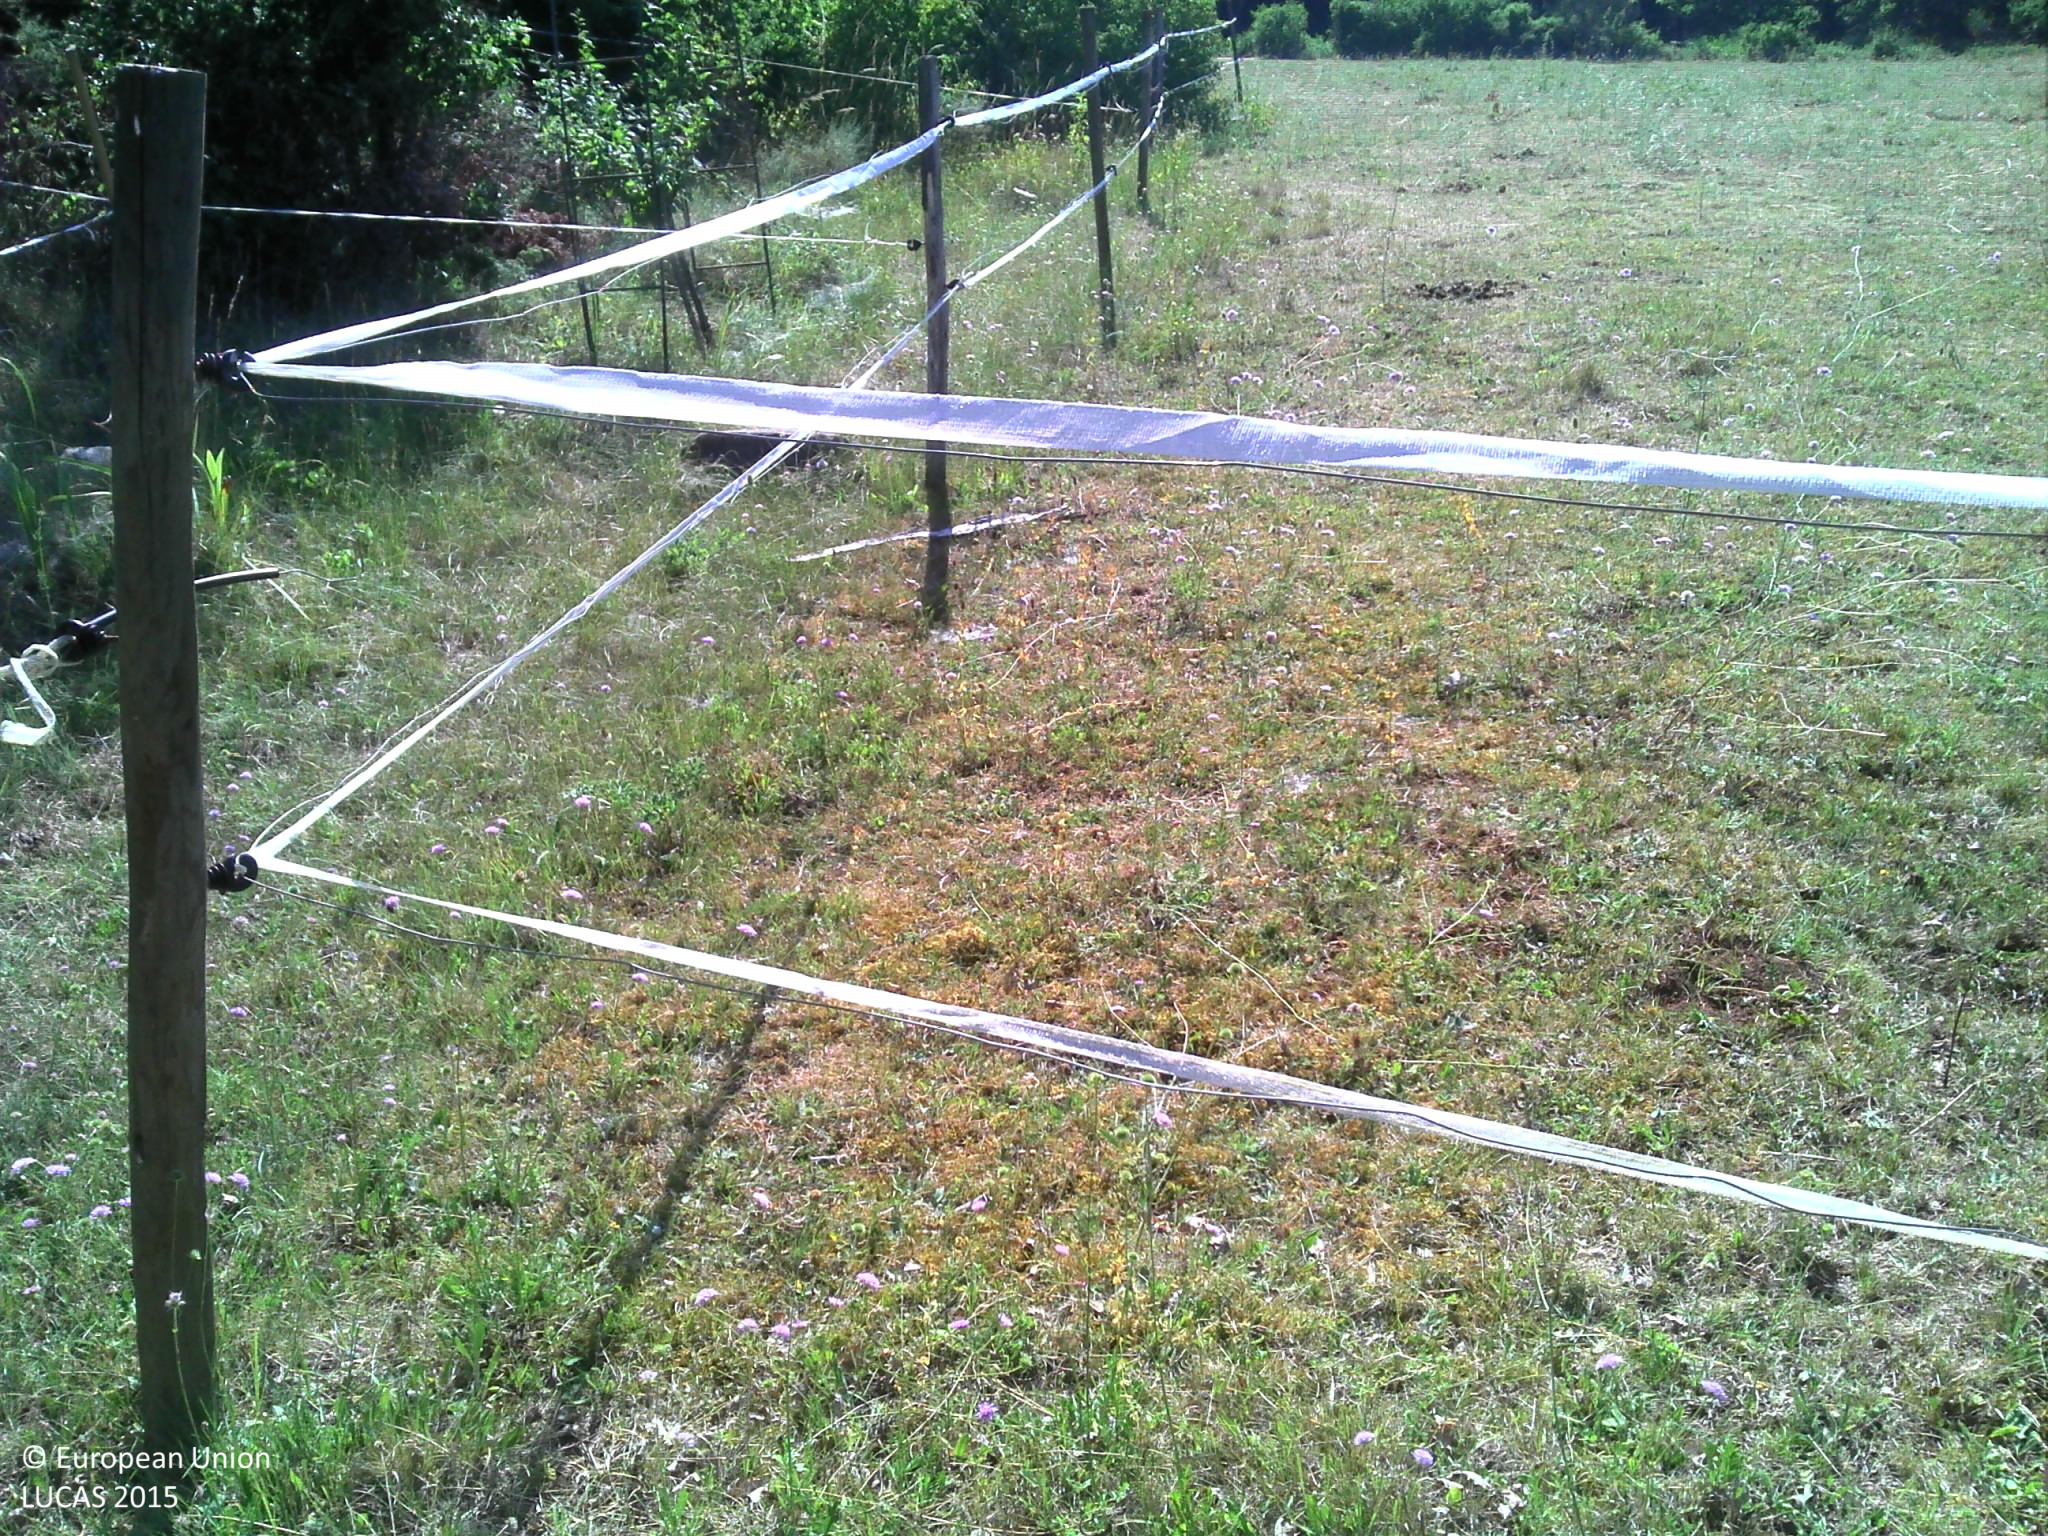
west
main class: Grassland
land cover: Grassland with sparse tree/shrub cover
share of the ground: > 75 %
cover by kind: herbaceous plants 95 %, coniferous forest trees 5 %
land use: Agriculture (excluding fallow land and kitchen gardens)
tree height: > 5 m
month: July
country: FR
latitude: 42.9297
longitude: 2.1550
